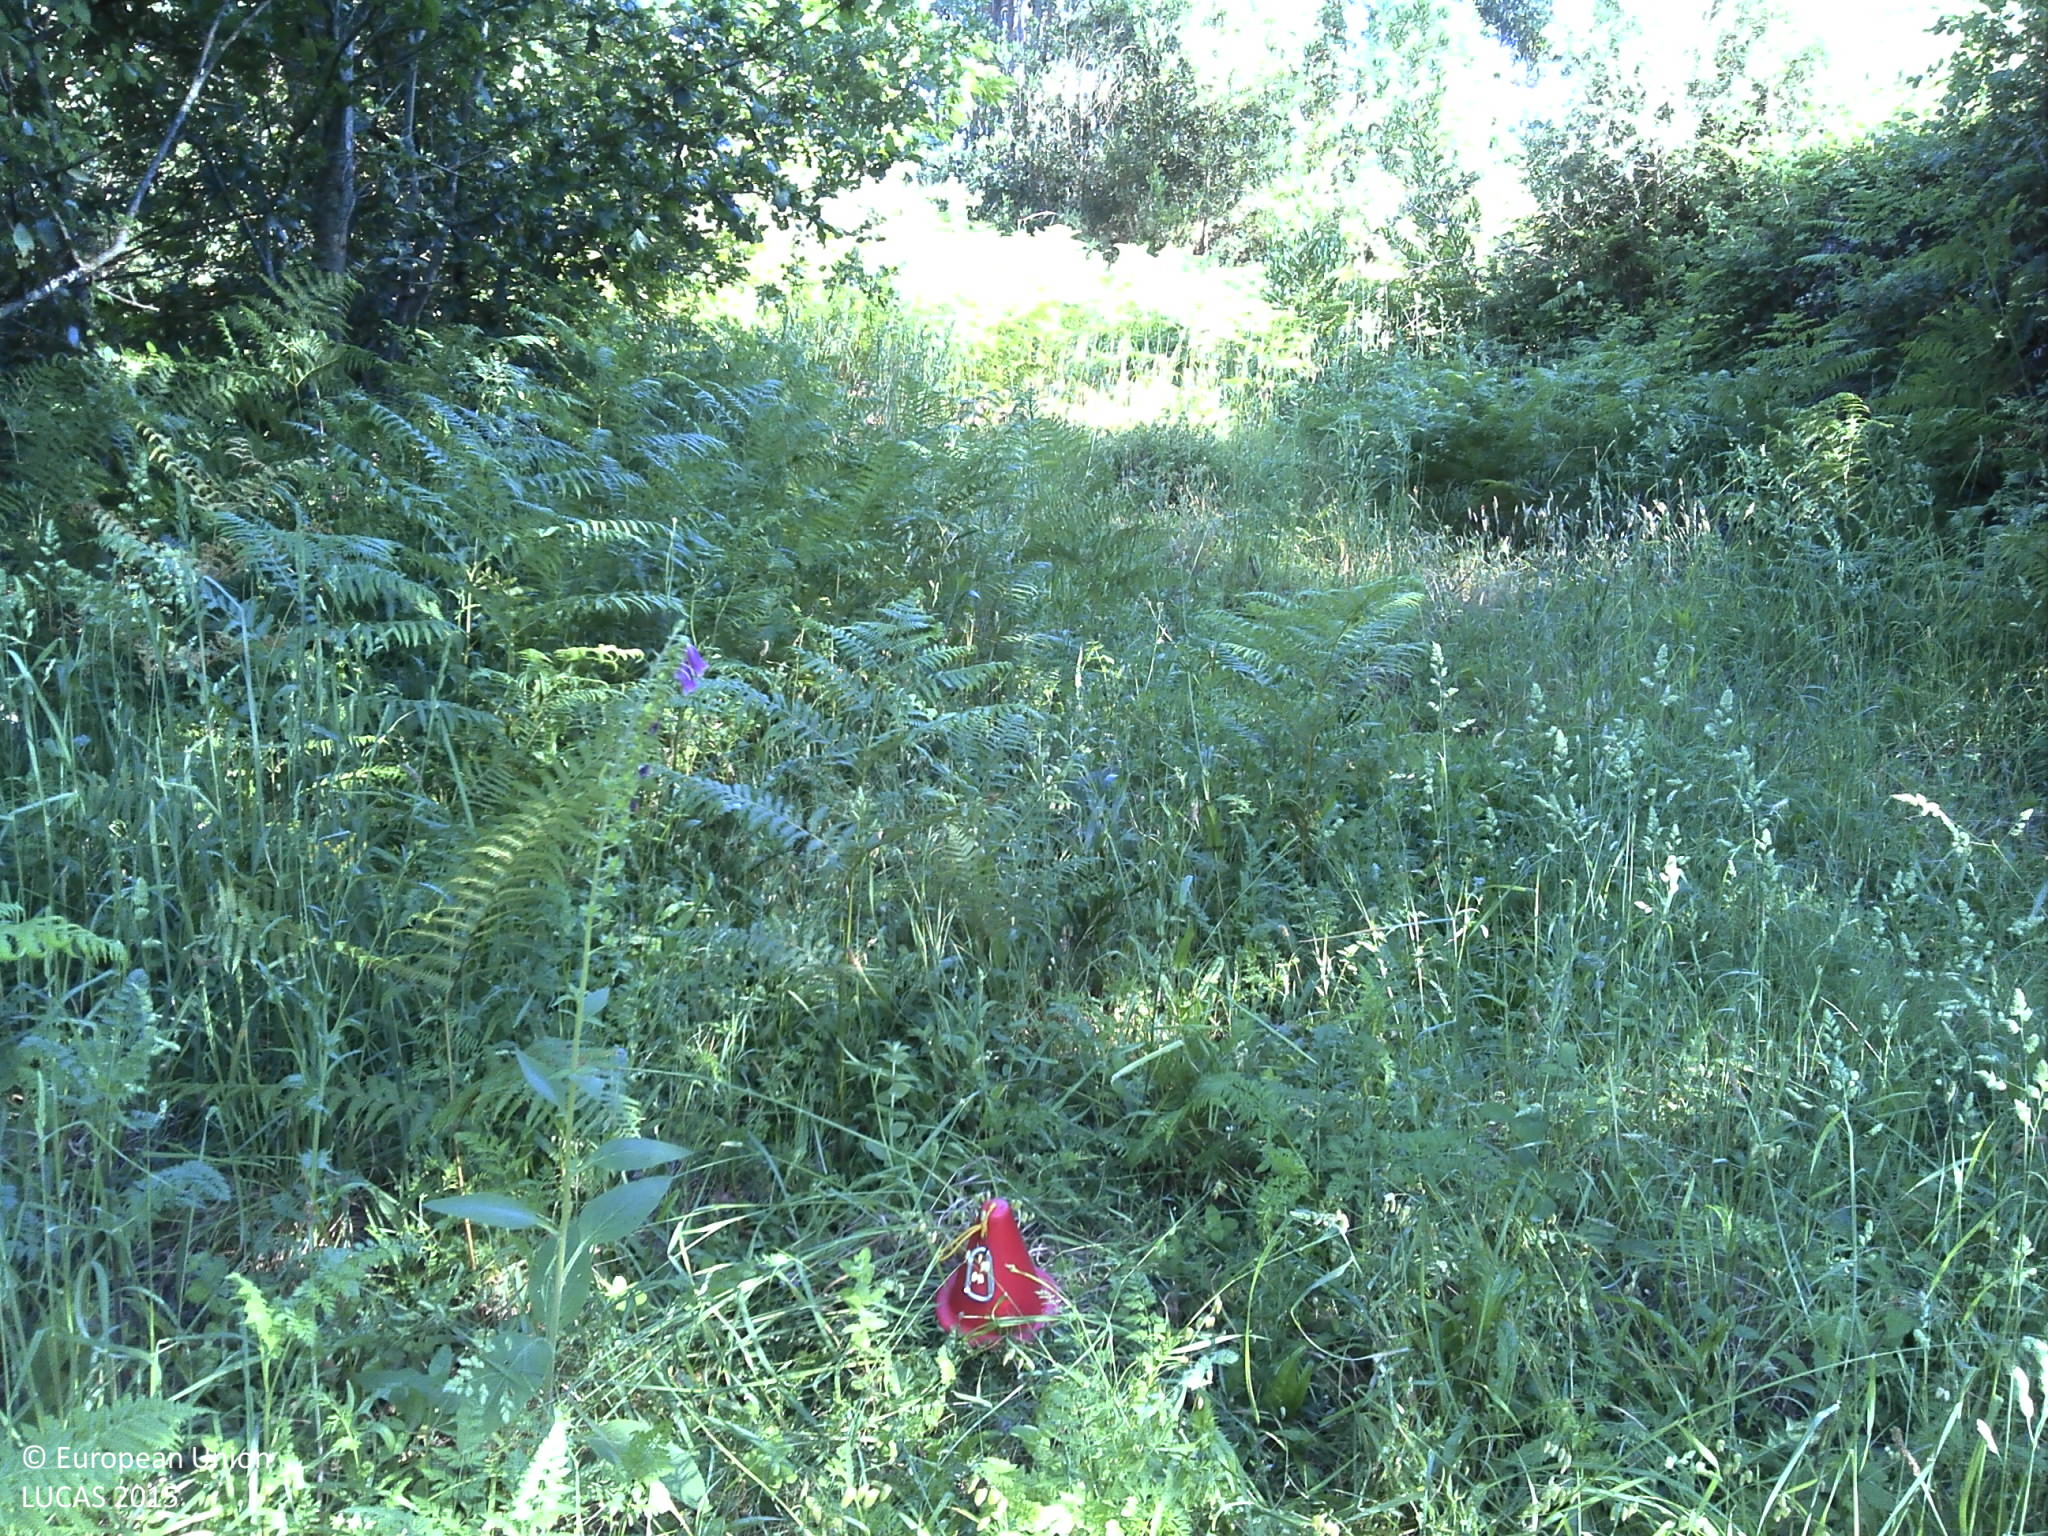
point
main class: Woodland
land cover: Broadleaved woodland
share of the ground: 25 - 50 %
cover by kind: broadleaved forest trees 35 %, herbaceous plants 35 %, unconsolidated bare surface 20 %, shrubs 10 %
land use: Forestry
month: May
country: PT
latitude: 41.7627
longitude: -8.7012
